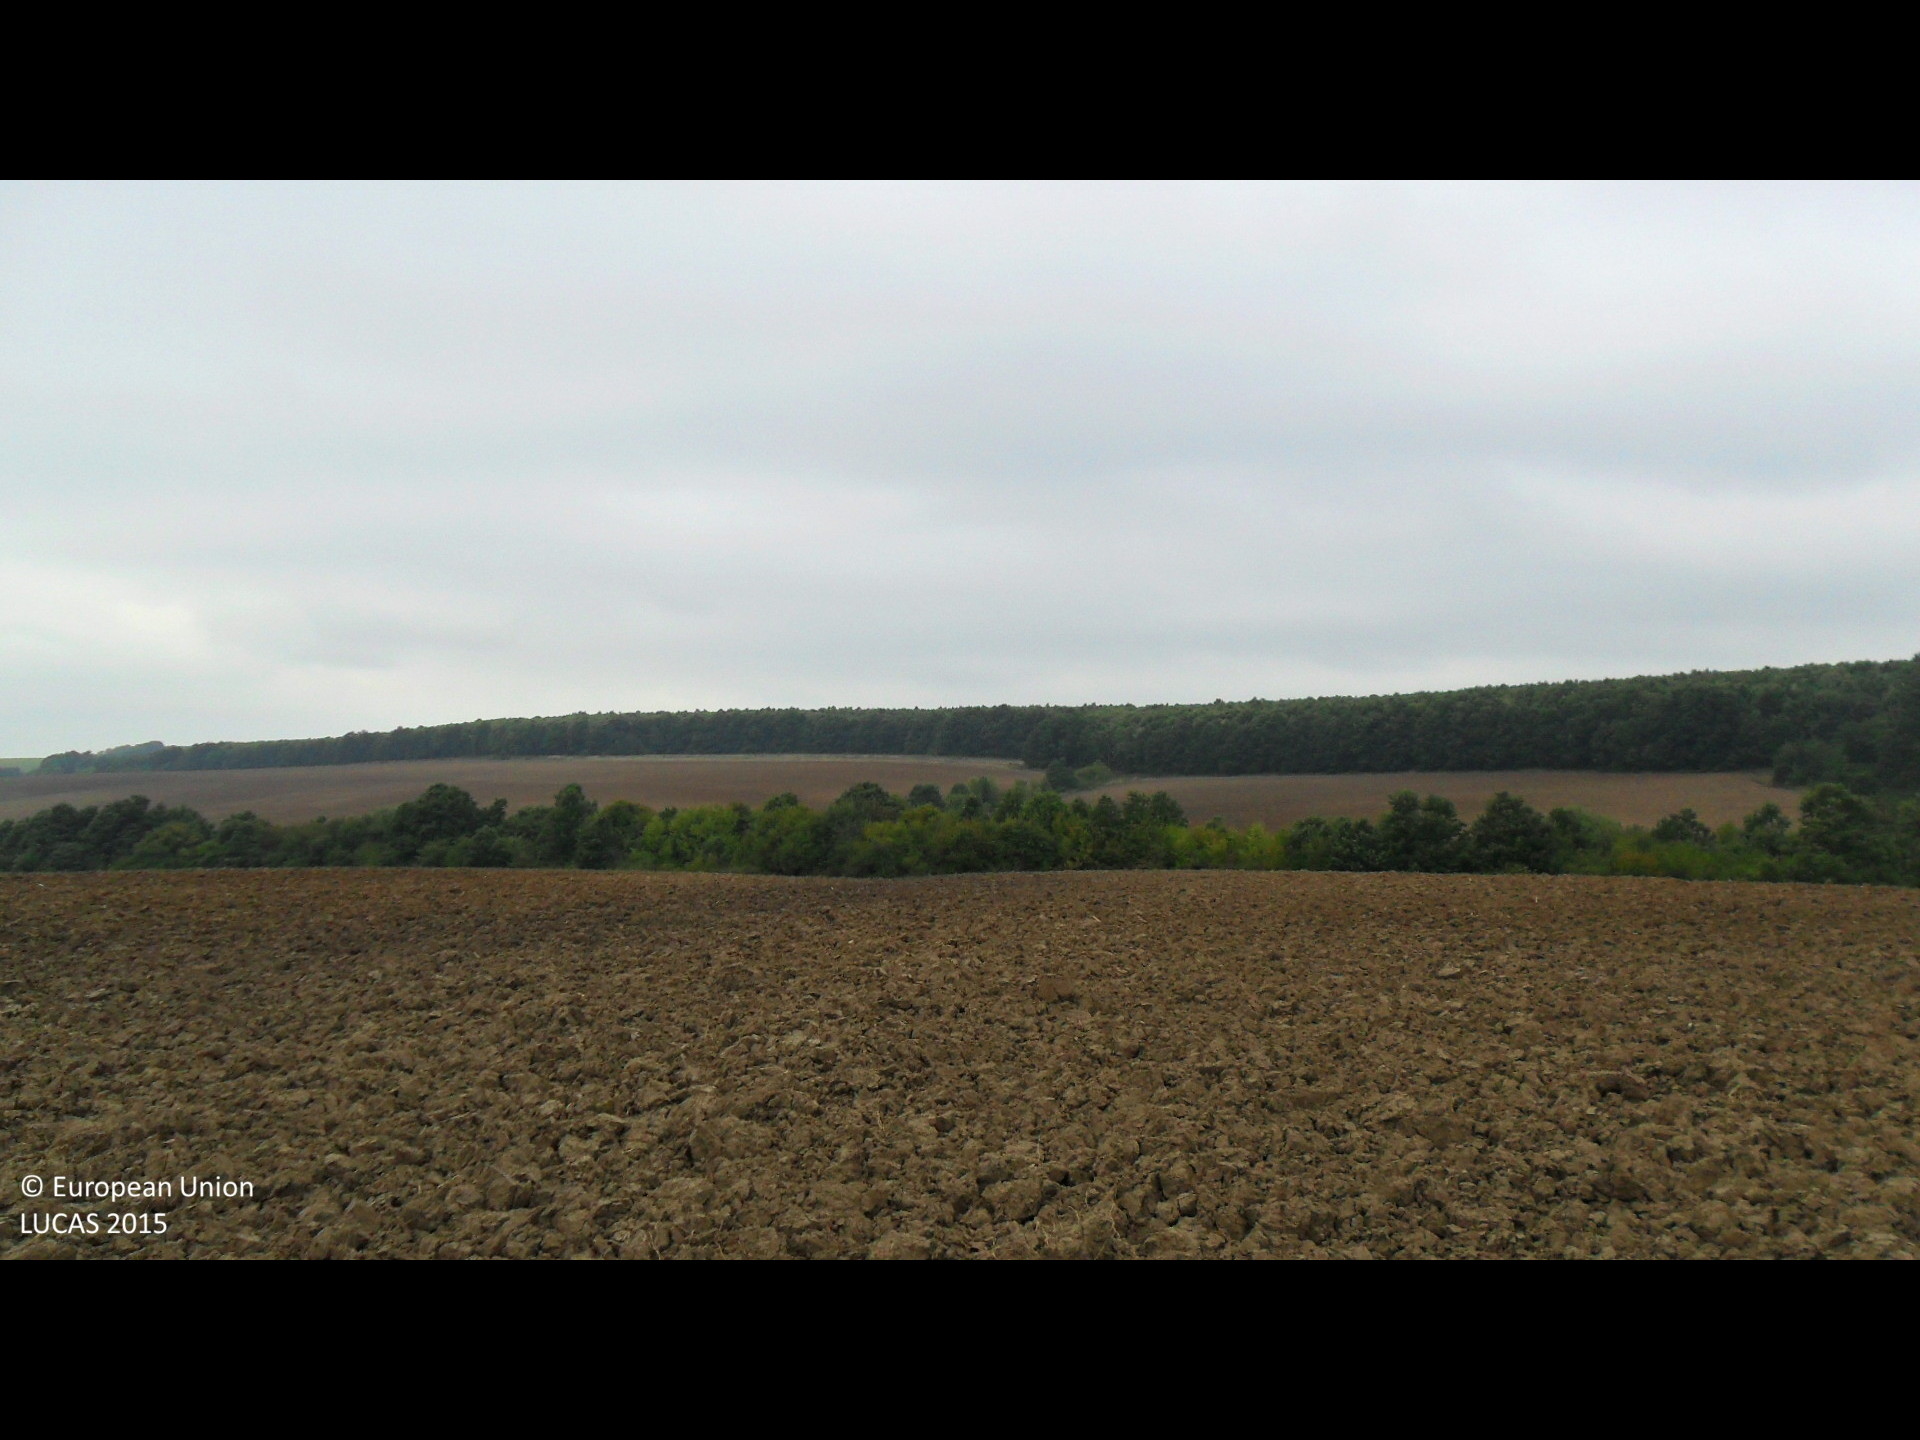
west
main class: Cropland
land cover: Maize
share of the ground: < 10 %
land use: Agriculture (excluding fallow land and kitchen gardens)
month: September
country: BG
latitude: 43.2736
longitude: 26.1737
